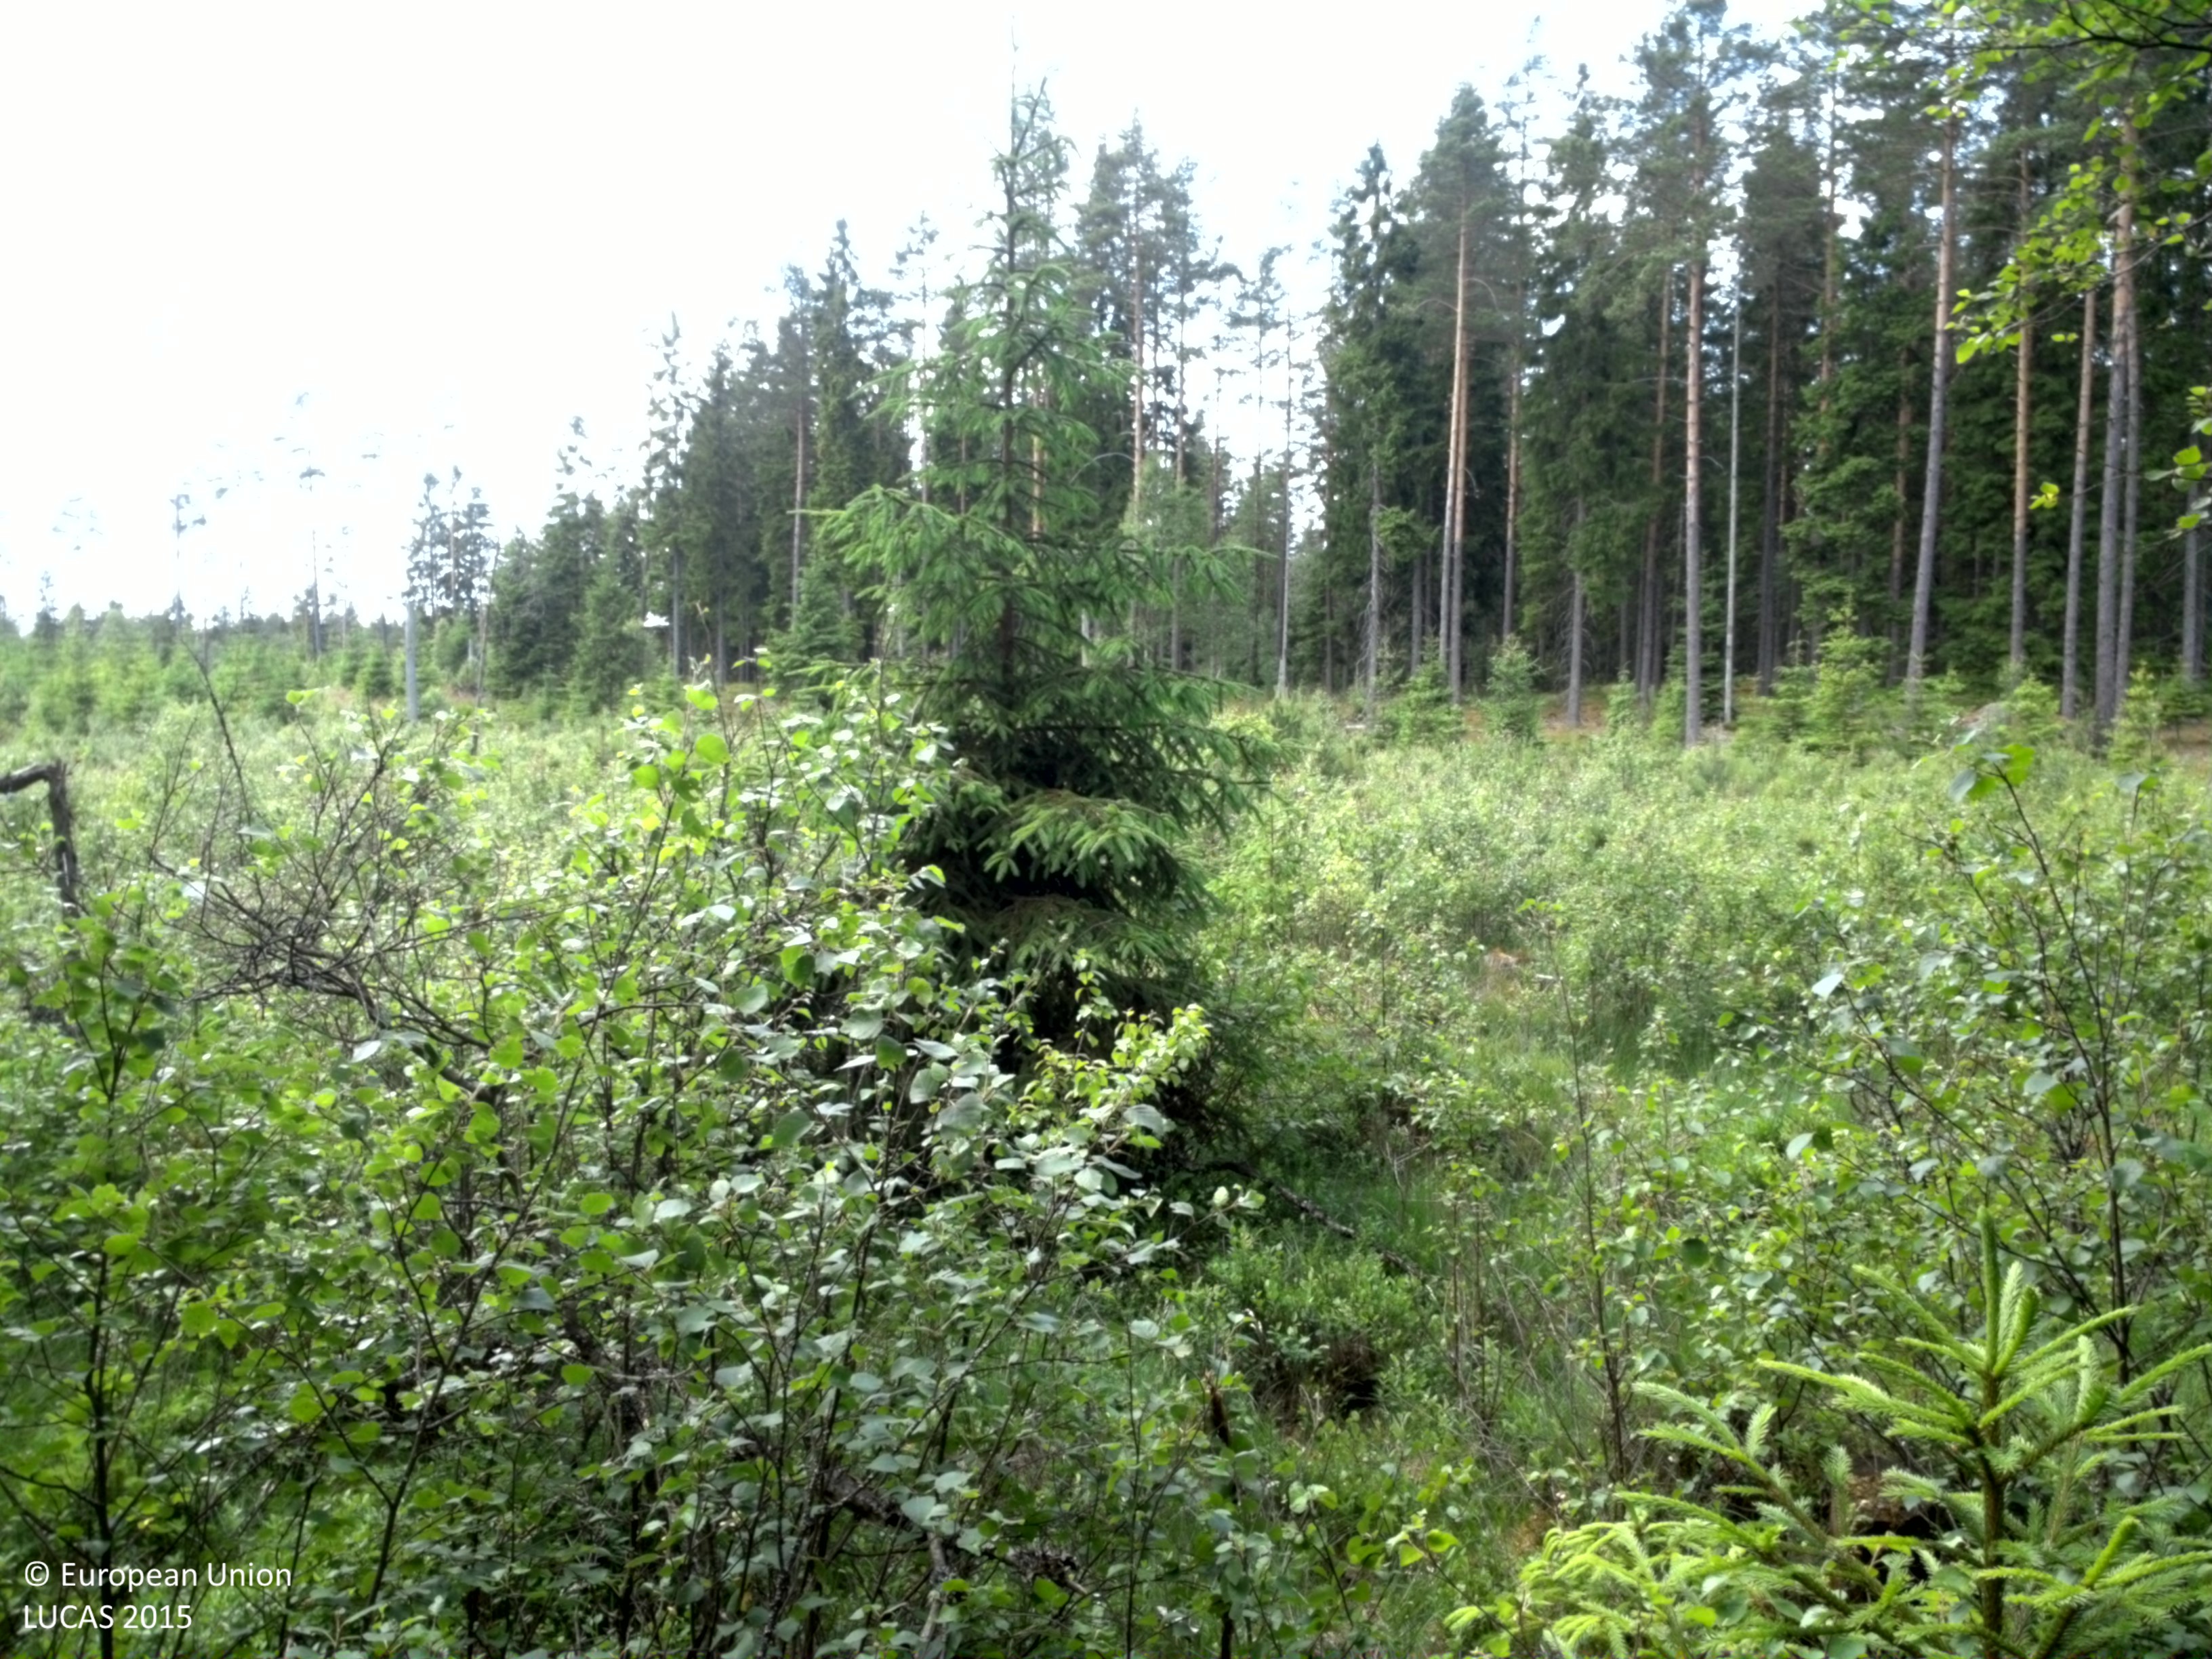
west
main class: Woodland
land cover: Spruce dominated mixed woodland
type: boreal forest
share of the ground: 50 - 75 %
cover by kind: coniferous forest trees 40 %, broadleaved forest trees 35 %, shrubs 20 %, herbaceous plants 5 %
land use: Forestry
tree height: > 5 m
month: July
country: SE
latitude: 57.6597
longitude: 13.8669
